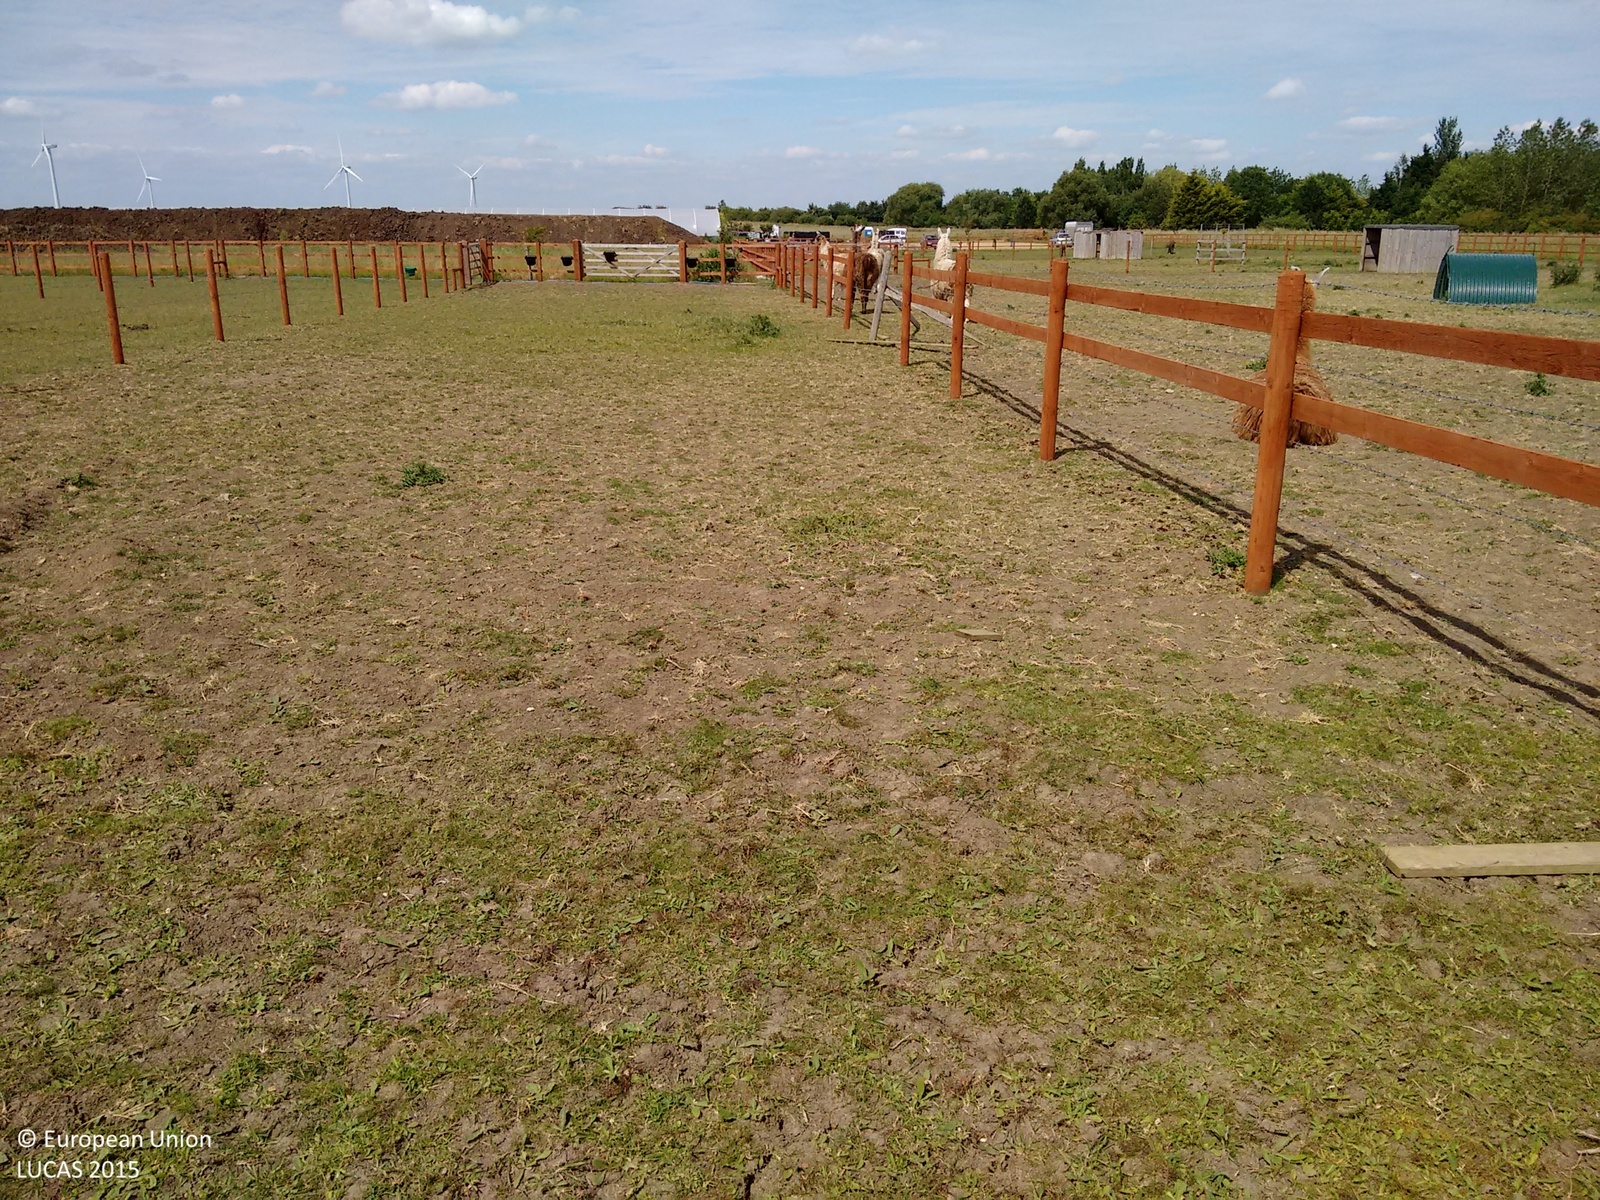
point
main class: Grassland
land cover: Grassland without tree/shrub cover
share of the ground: > 75 %
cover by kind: herbaceous plants 100 %
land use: Agriculture (excluding fallow land and kitchen gardens)
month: June
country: GB
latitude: 52.5023
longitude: 0.0537
